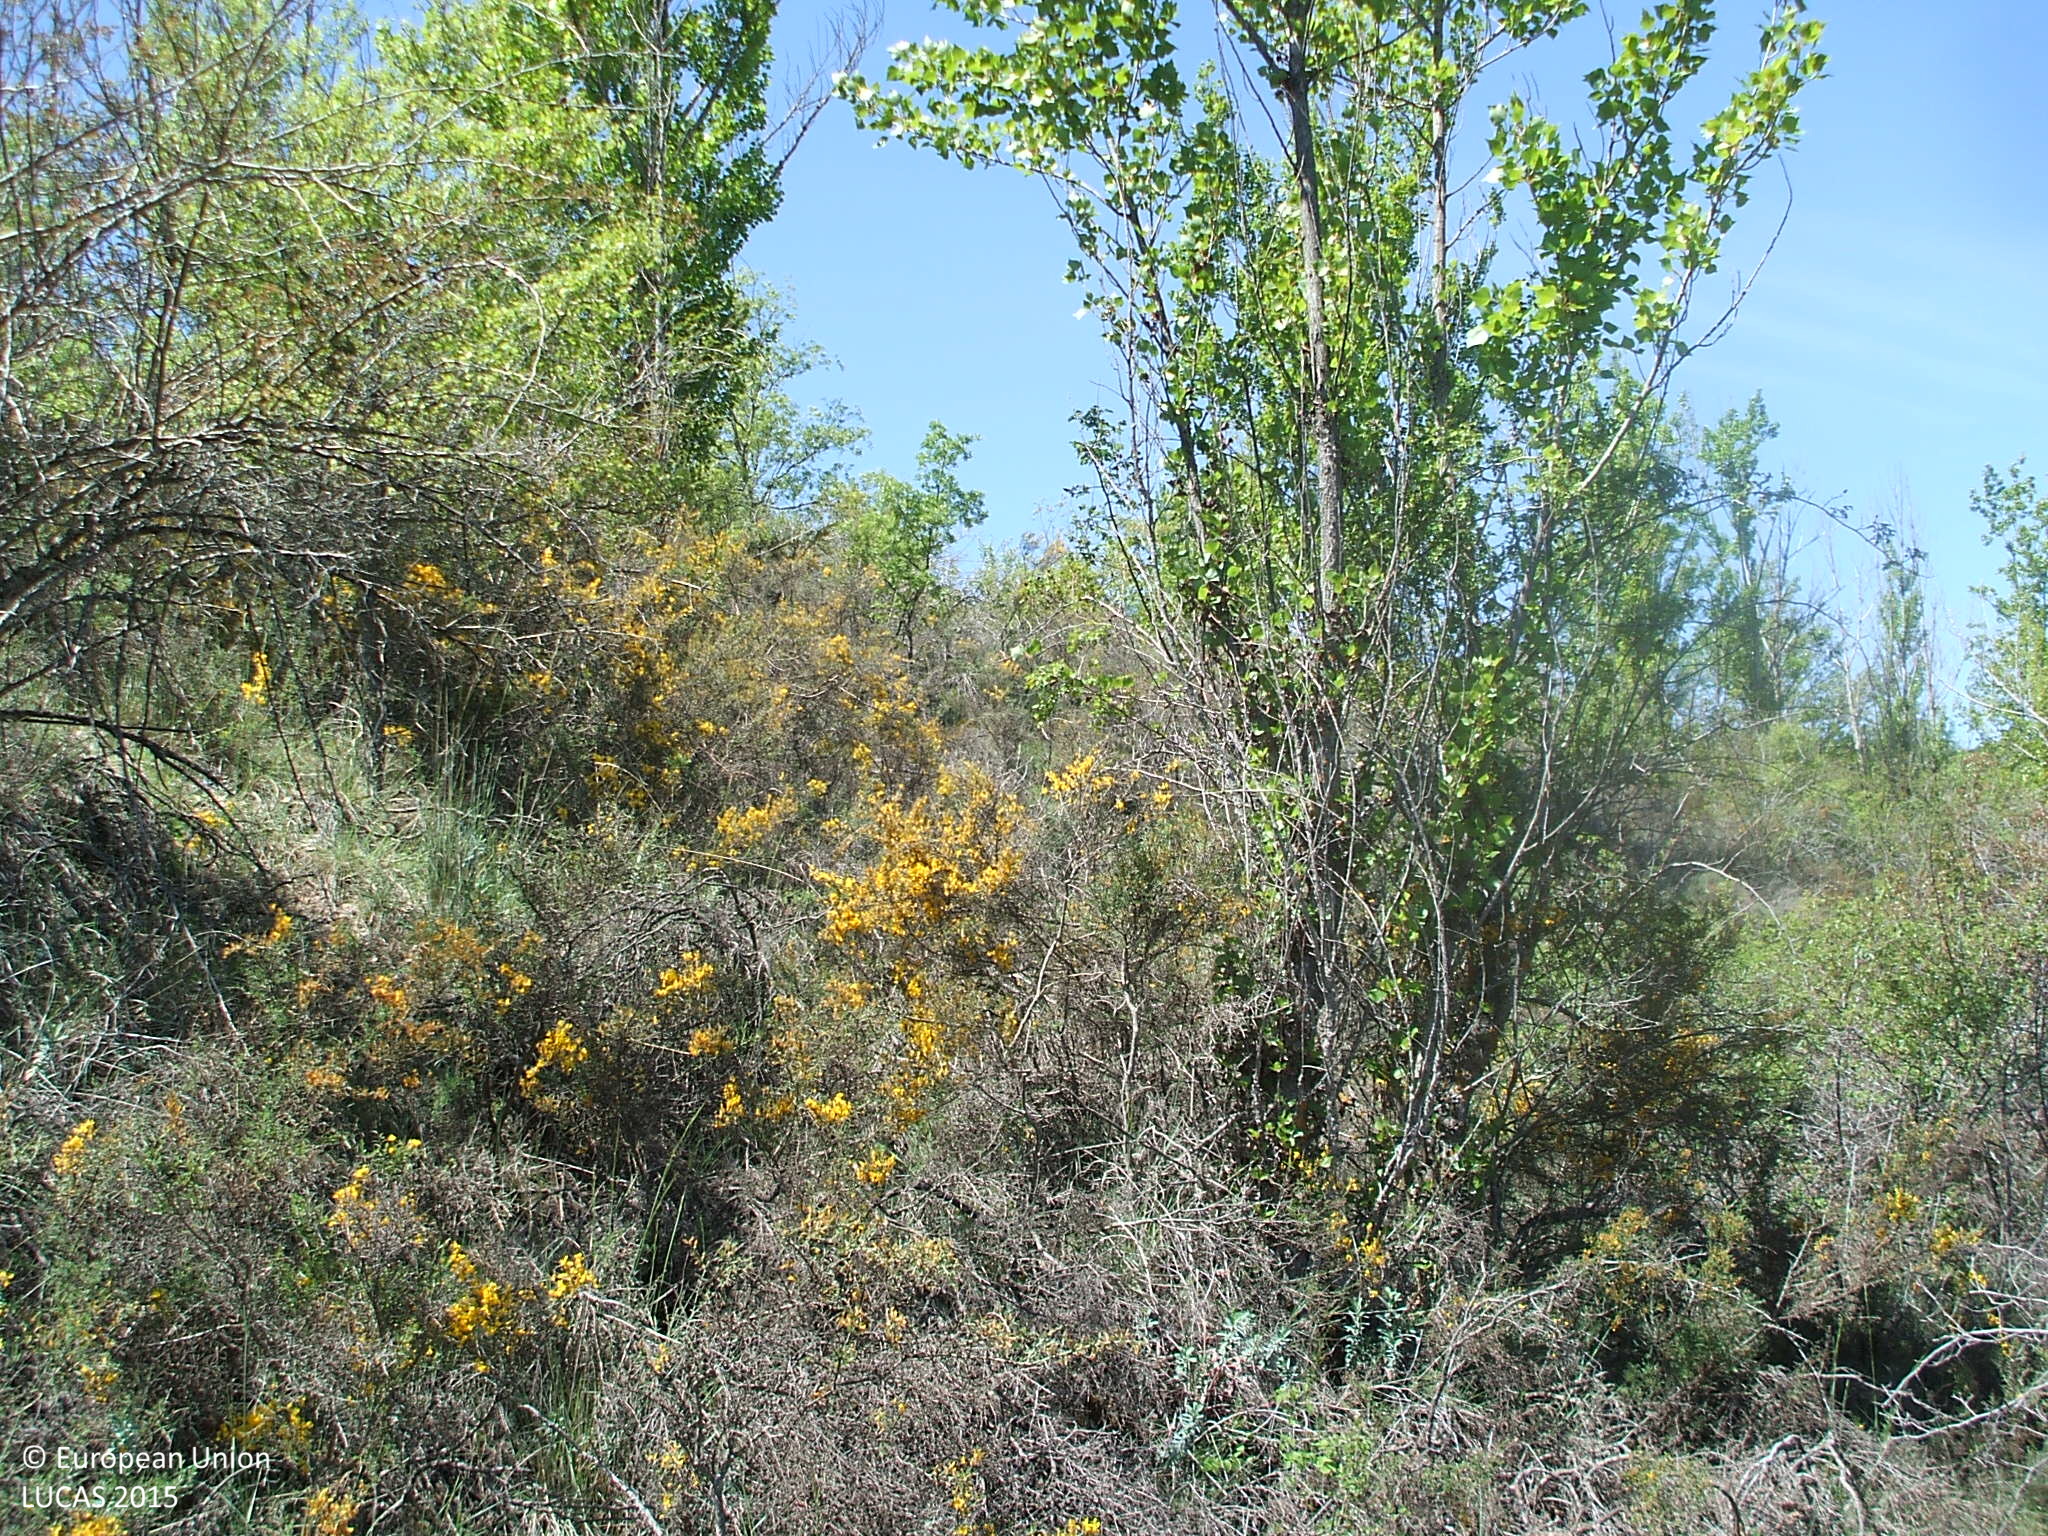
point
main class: Shrubland
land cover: Shrubland with sparse tree cover
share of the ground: > 75 %
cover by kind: shrubs 95 %, broadleaved forest trees 5 %
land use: Semi-natural and natural areas not in use
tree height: > 5 m
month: May
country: ES
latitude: 40.7403
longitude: -2.9519
